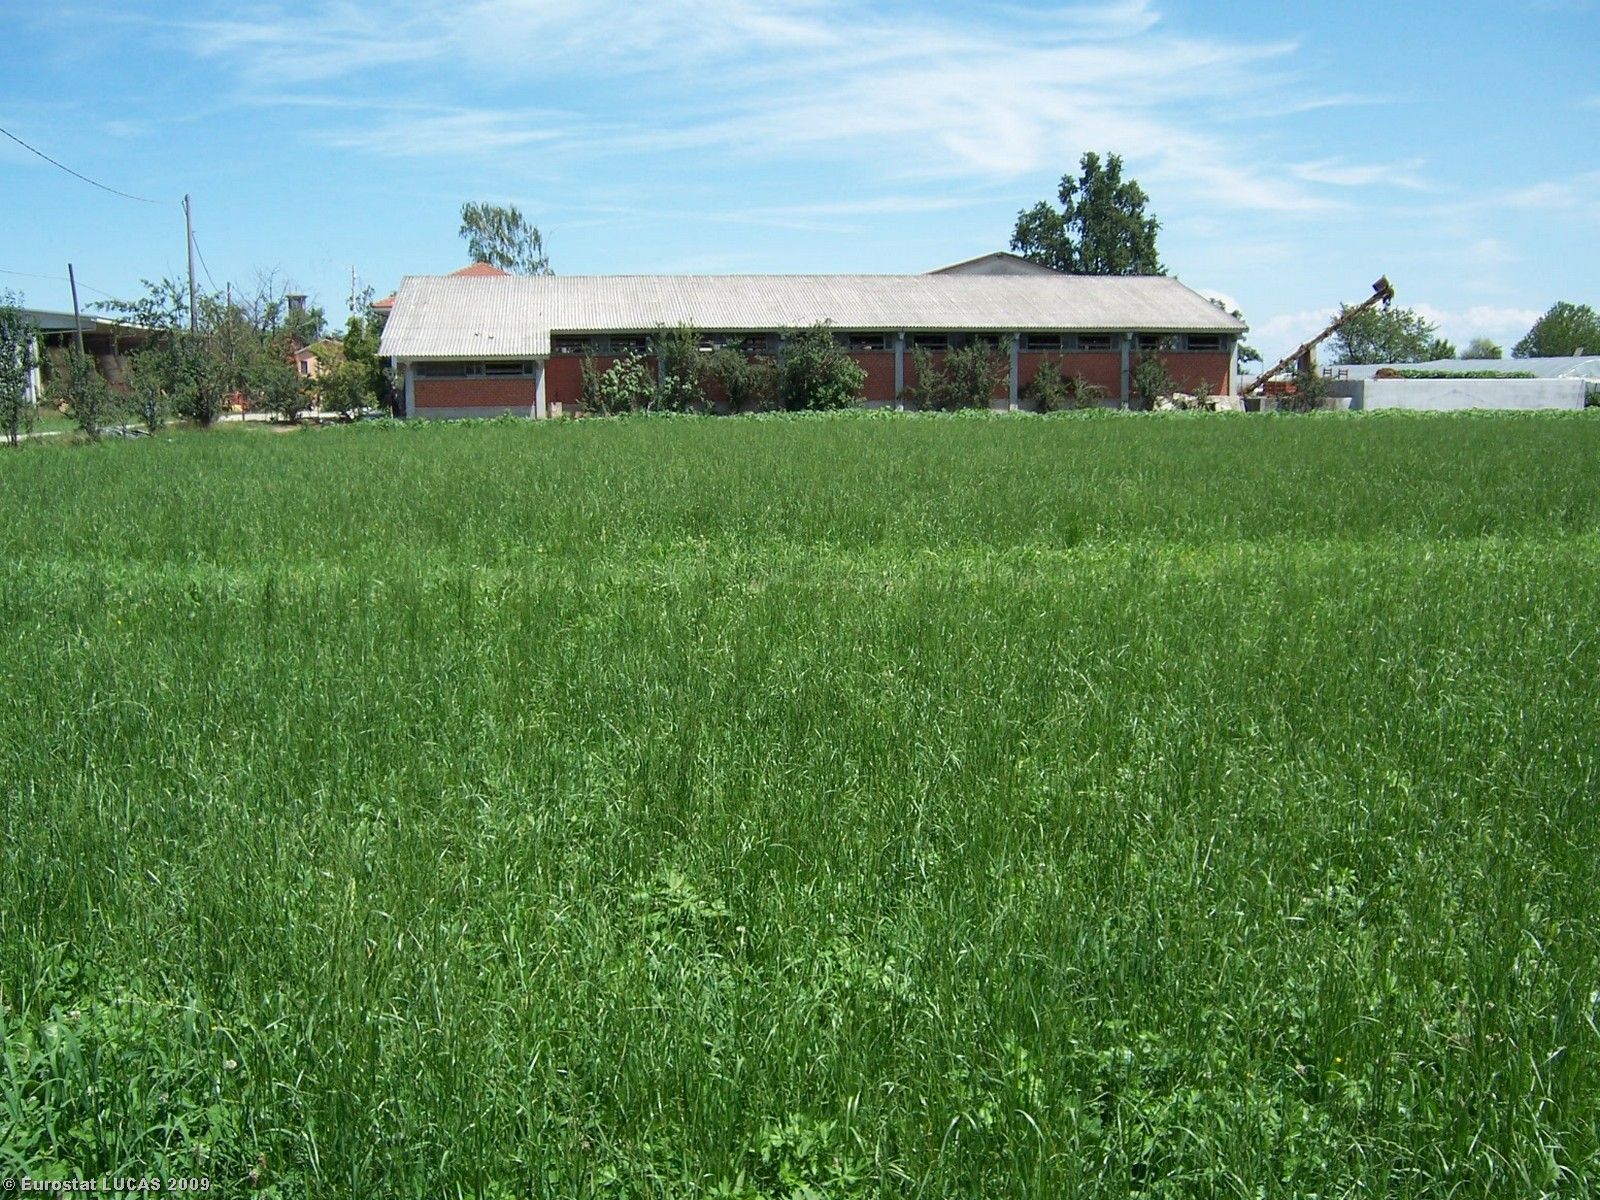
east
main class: Grassland
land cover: Grassland without tree/shrub cover
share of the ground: > 75 %
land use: Agriculture (excluding fallow land and kitchen gardens)
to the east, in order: Grassland without tree/shrub cover; Ditches and canals; Grassland without tree/shrub cover; Other fresh vegetables; Abandoned hedges; Artificial constructions in urban areas; Other fresh vegetables; Grassland without tree/shrub cover; Ditches and canals; Grassland without tree/shrub cover
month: July
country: IT
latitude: 44.7874
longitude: 7.4138
